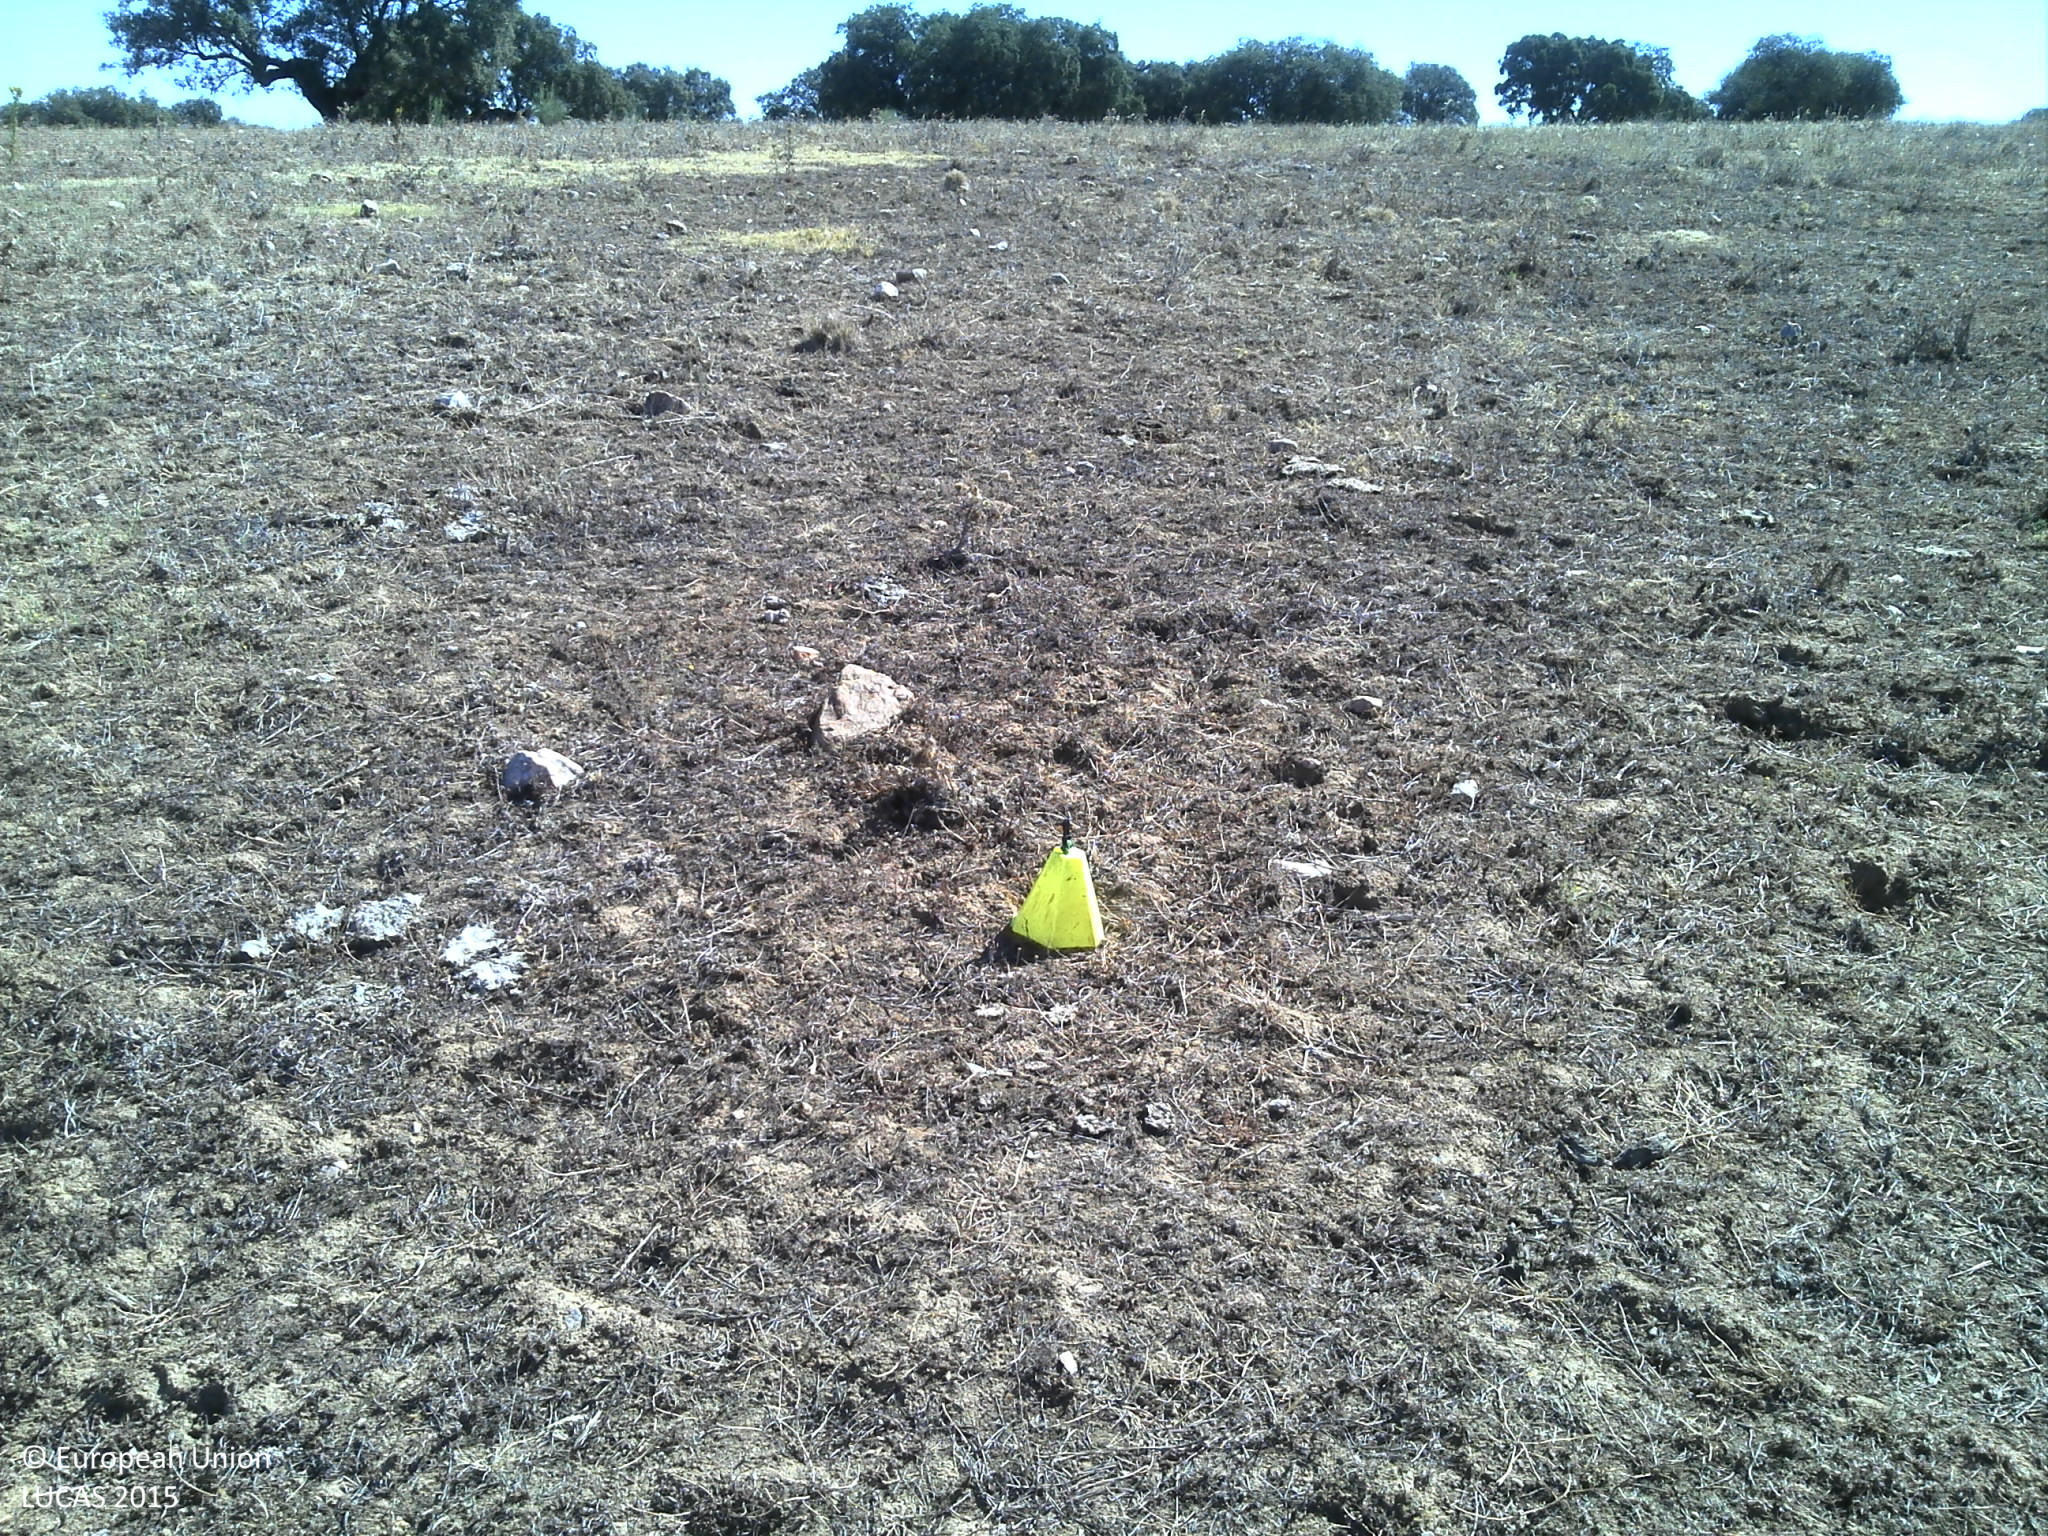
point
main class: Grassland
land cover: Grassland without tree/shrub cover
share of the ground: 10 - 25 %
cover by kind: unconsolidated bare surface 85 %, herbaceous plants 15 %
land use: Agriculture (excluding fallow land and kitchen gardens)
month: July
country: PT
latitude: 39.0765
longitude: -7.1503
